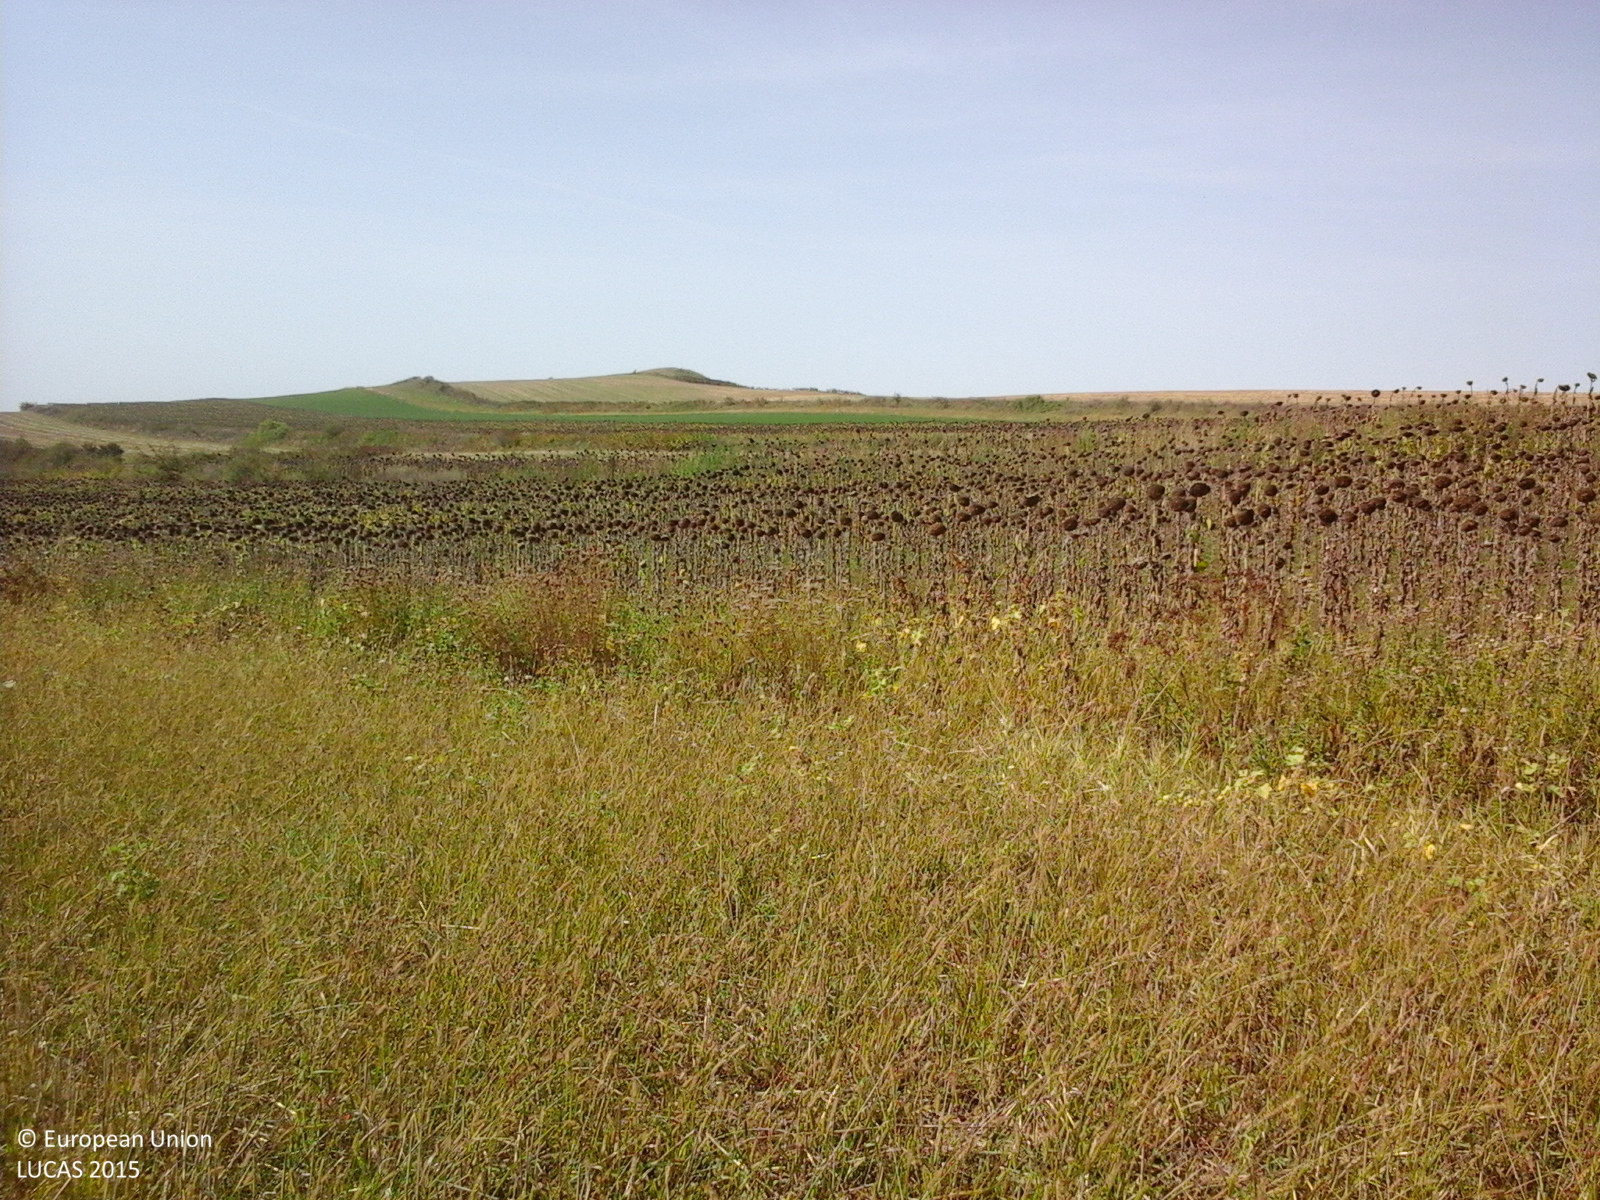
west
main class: Grassland
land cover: Grassland without tree/shrub cover
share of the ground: > 75 %
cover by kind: herbaceous plants 100 %
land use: Agriculture (excluding fallow land and kitchen gardens)
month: September
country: RO
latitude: 46.7420
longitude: 24.1247
